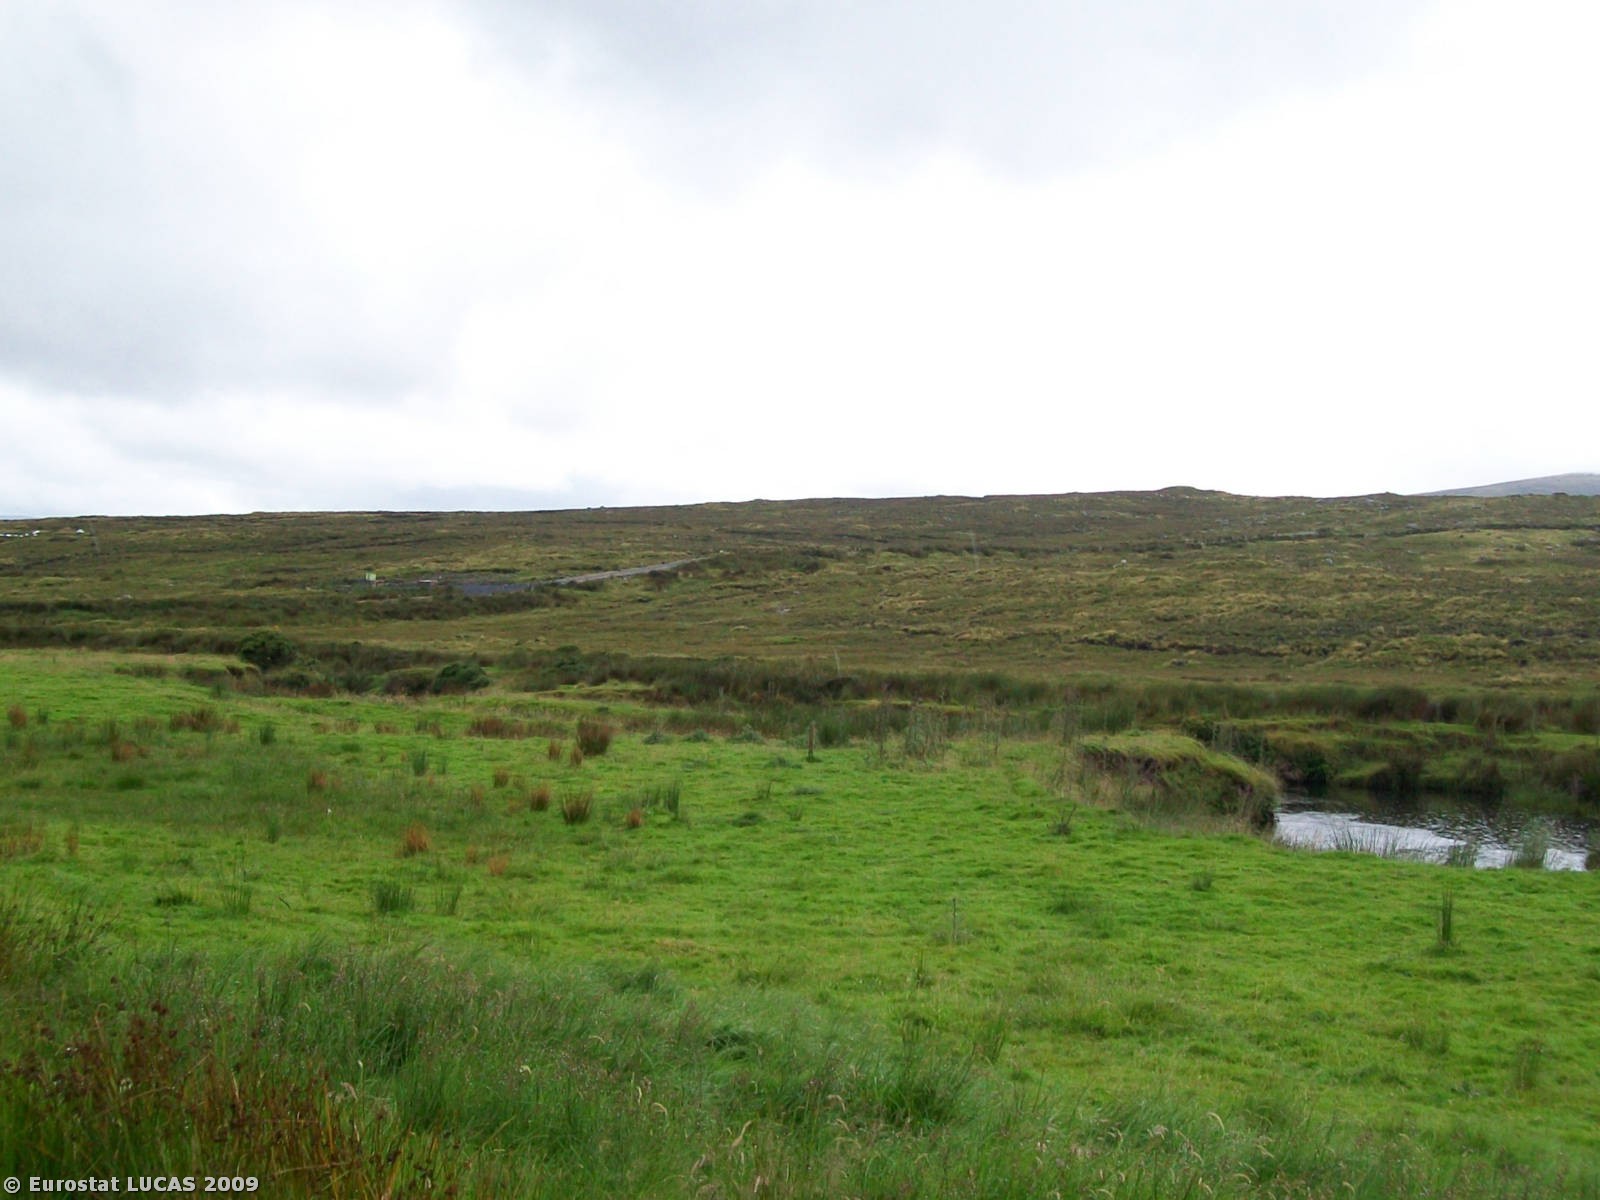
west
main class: Wetlands
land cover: Peatbogs
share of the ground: > 75 %
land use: Nature reserves
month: July
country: IE
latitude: 53.9192
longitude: -9.6516
